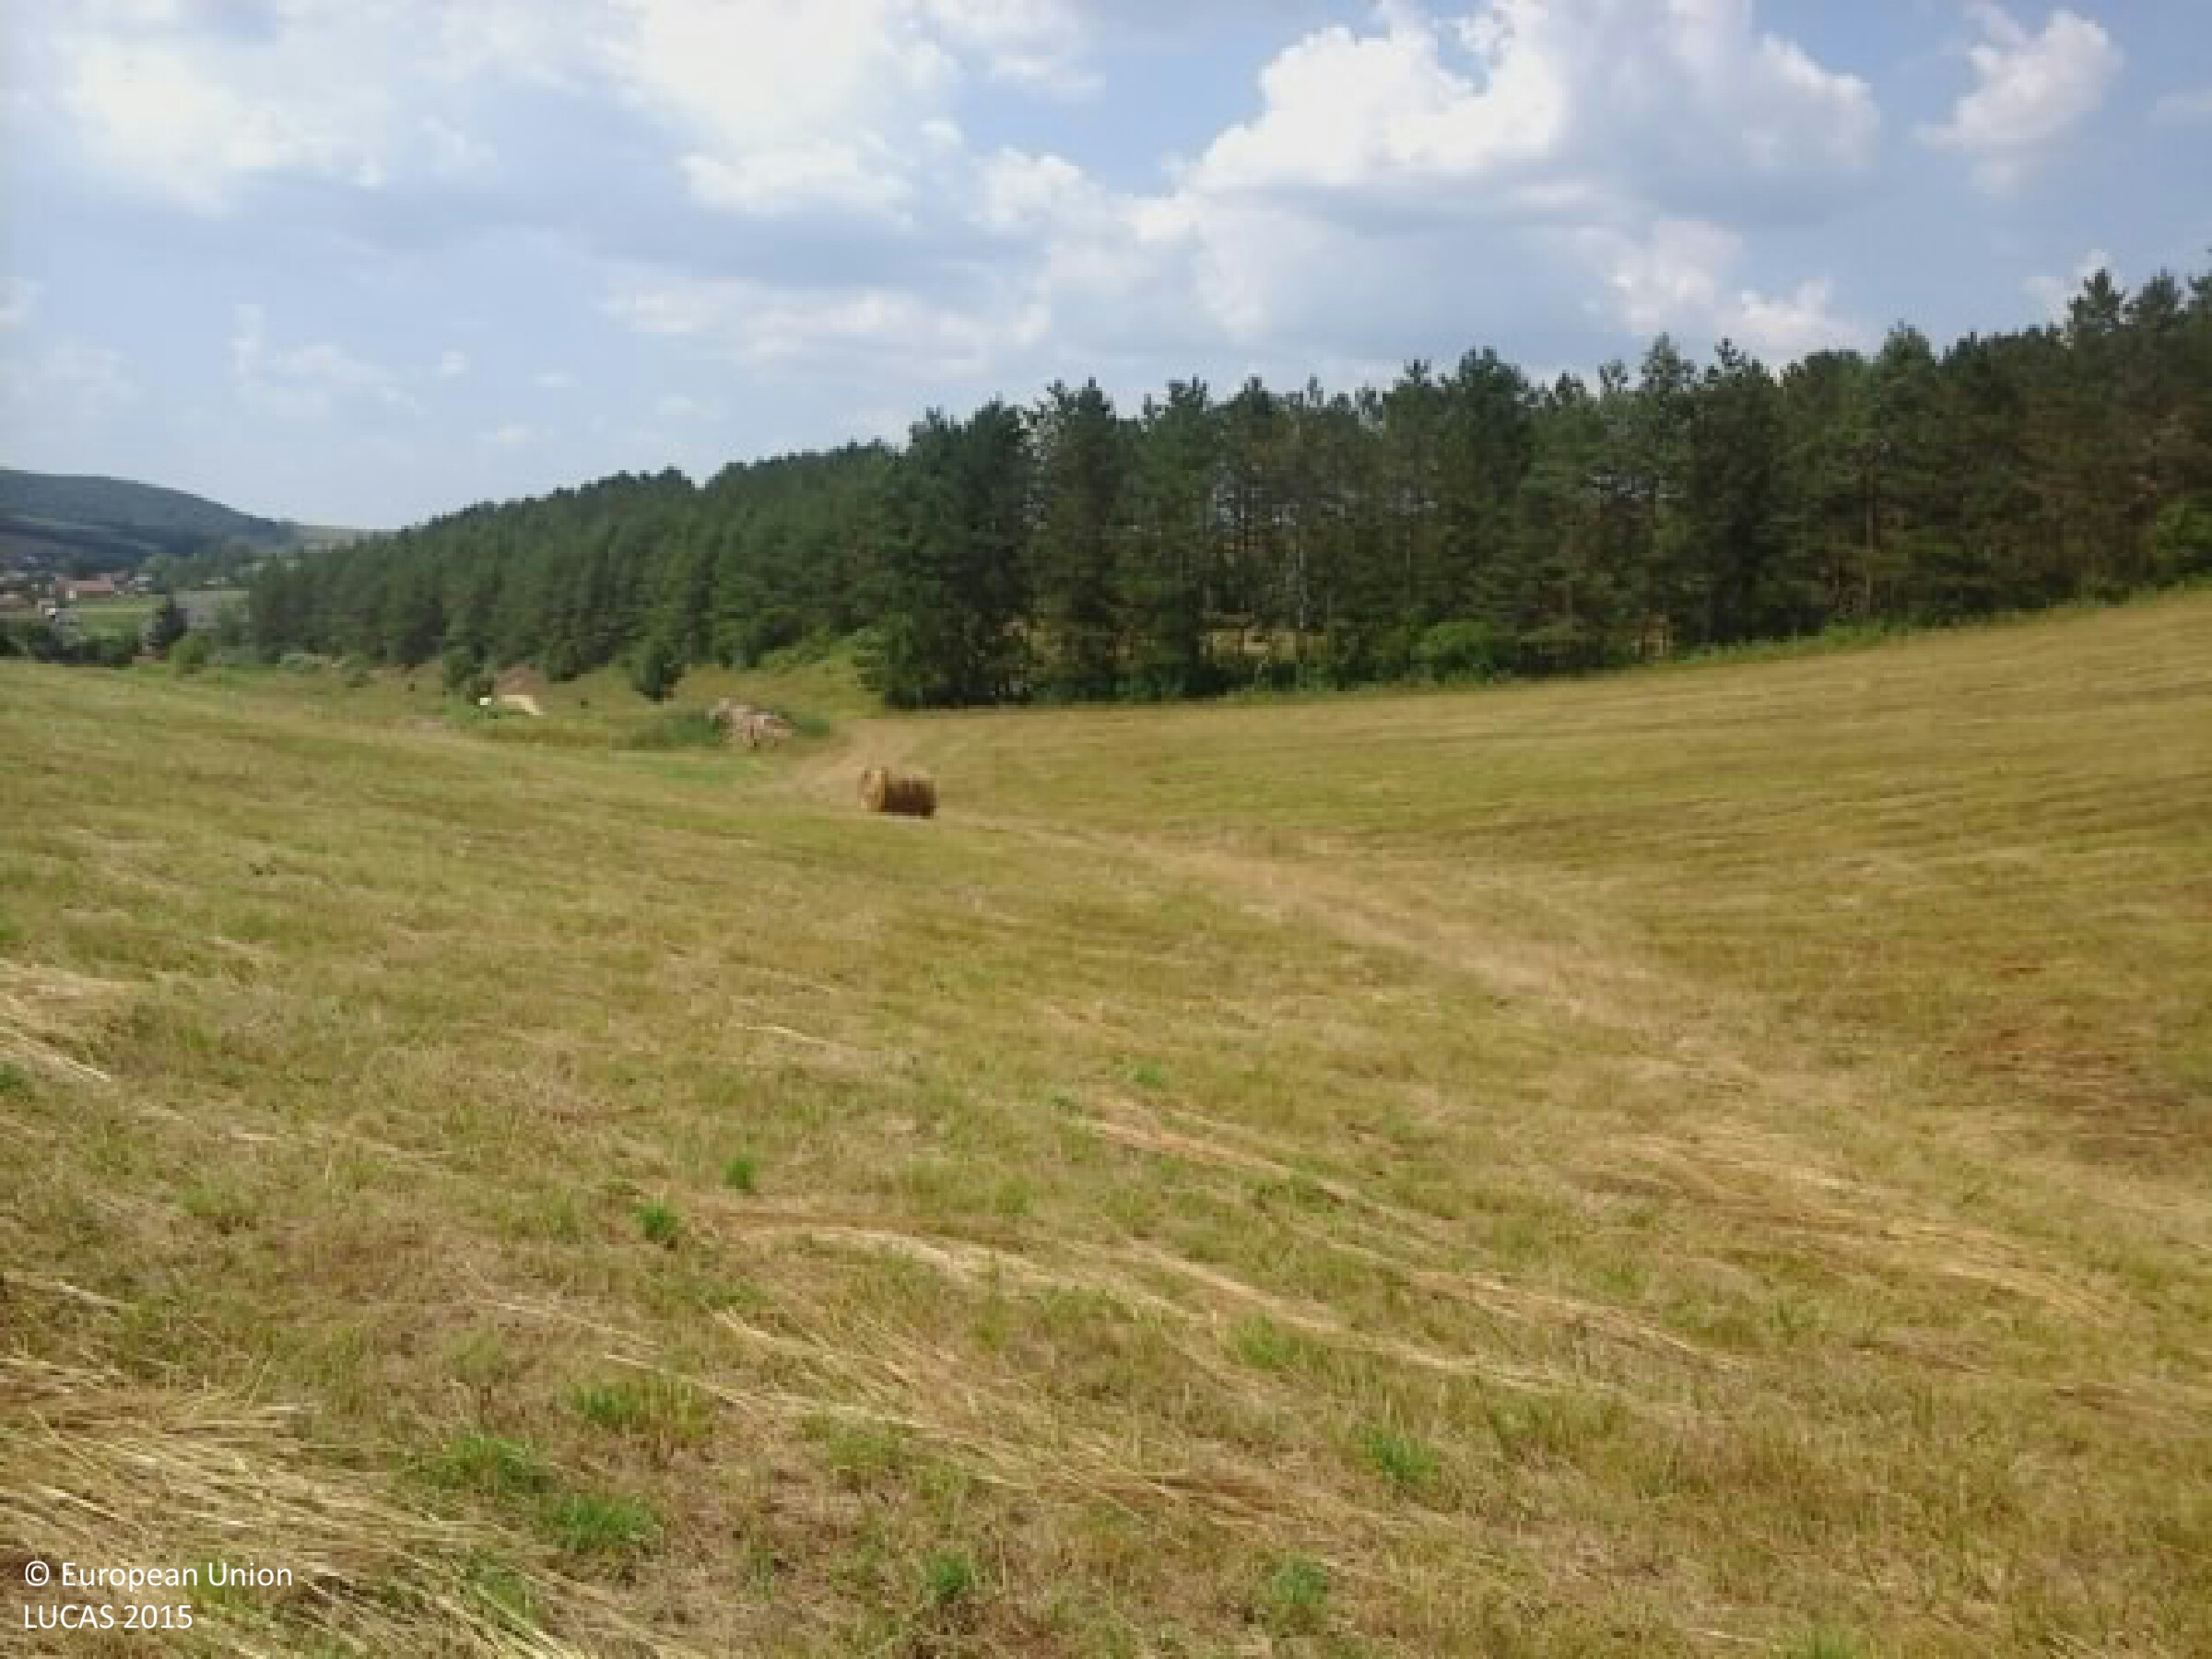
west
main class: Grassland
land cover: Grassland without tree/shrub cover
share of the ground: > 75 %
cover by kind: herbaceous plants 100 %
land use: Agriculture (excluding fallow land and kitchen gardens)
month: July
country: HU
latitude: 47.9820
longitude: 20.0365
